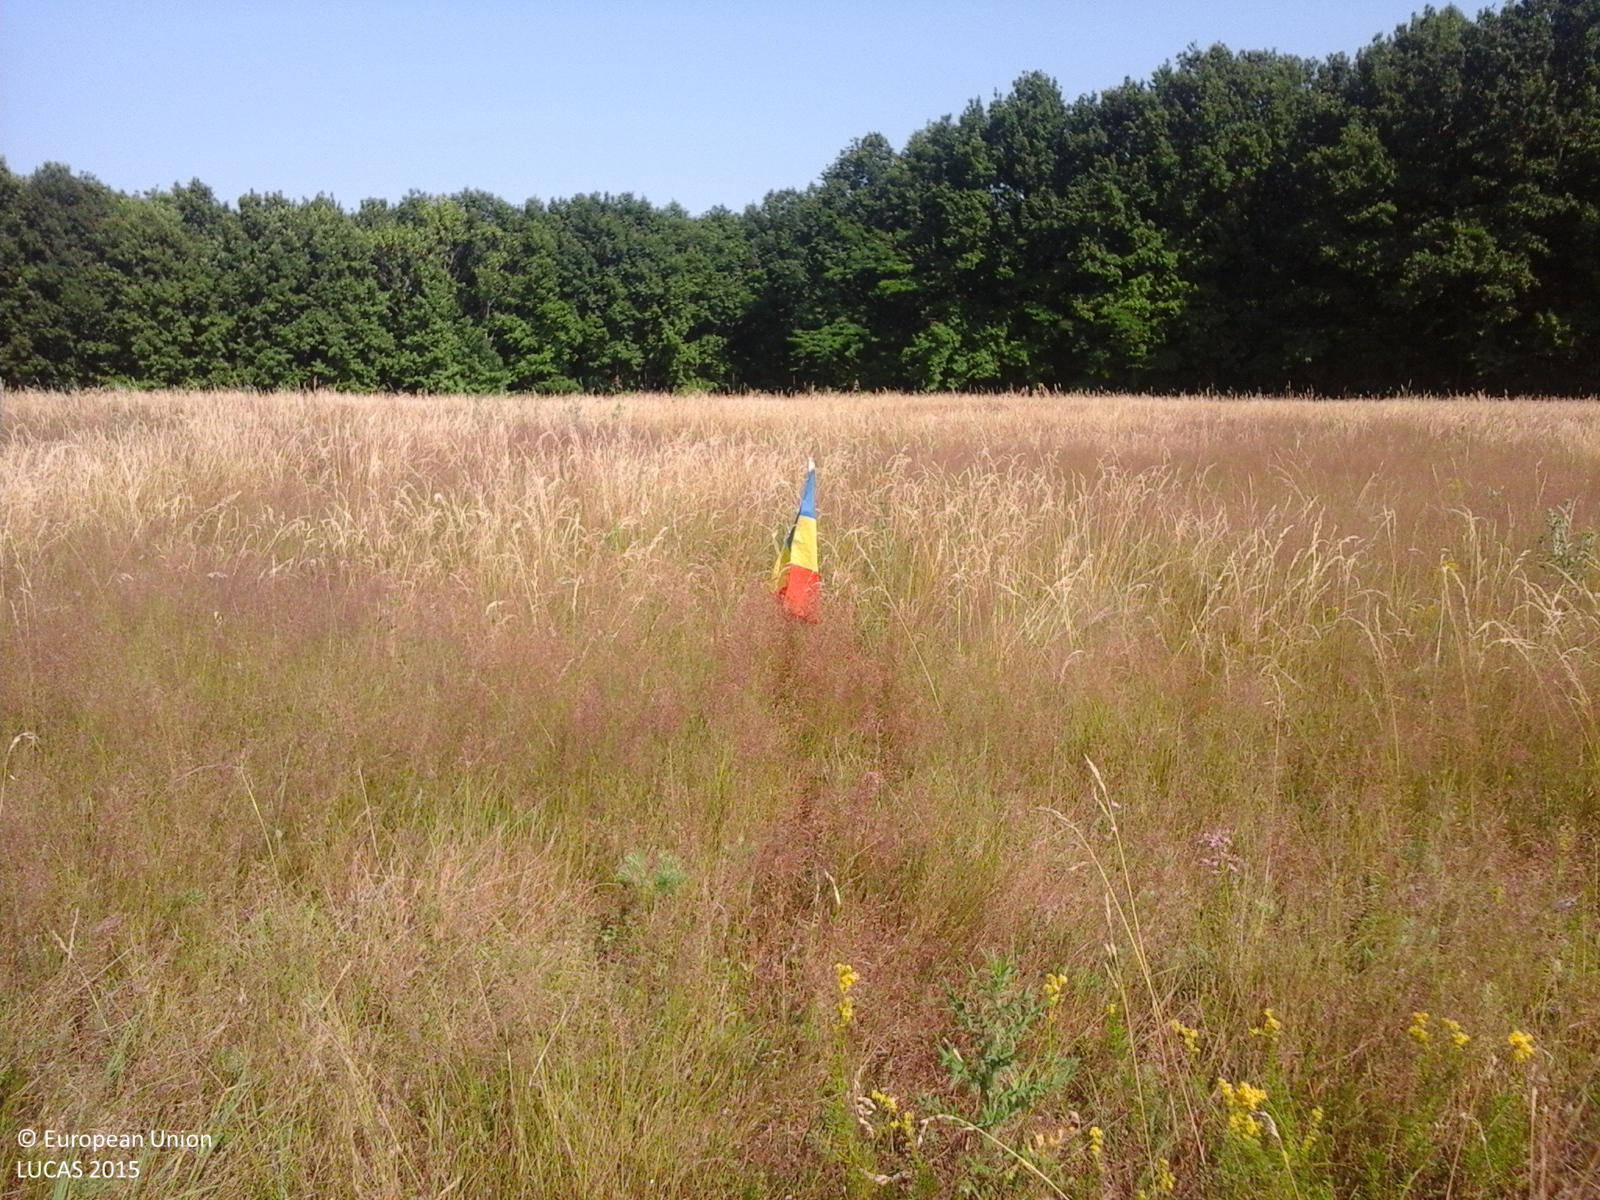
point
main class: Grassland
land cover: Grassland without tree/shrub cover
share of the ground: > 75 %
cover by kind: herbaceous plants 100 %
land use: Agriculture (excluding fallow land and kitchen gardens)
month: July
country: RO
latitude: 44.8539
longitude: 24.6931
